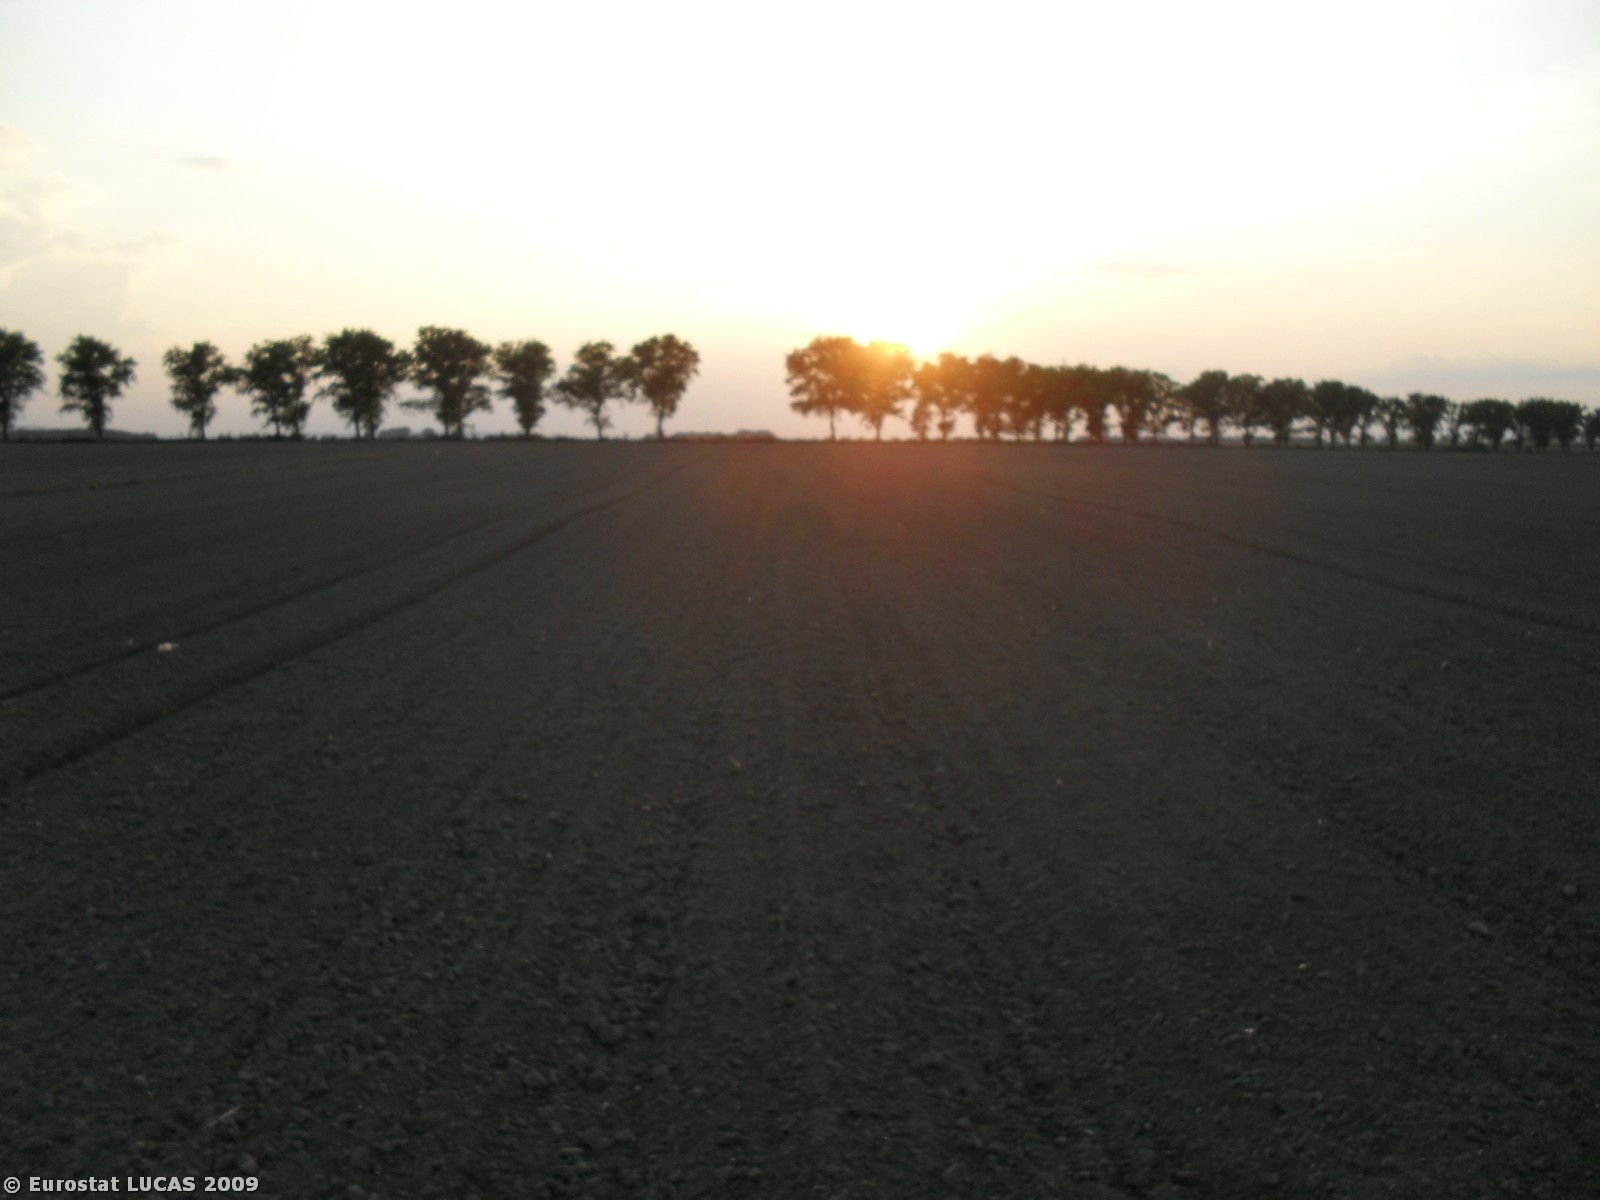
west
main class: Cropland
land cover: Common wheat
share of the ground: < 10 %
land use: Agriculture (excluding fallow land and kitchen gardens)
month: September
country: PL
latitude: 50.7600
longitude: 17.3411
